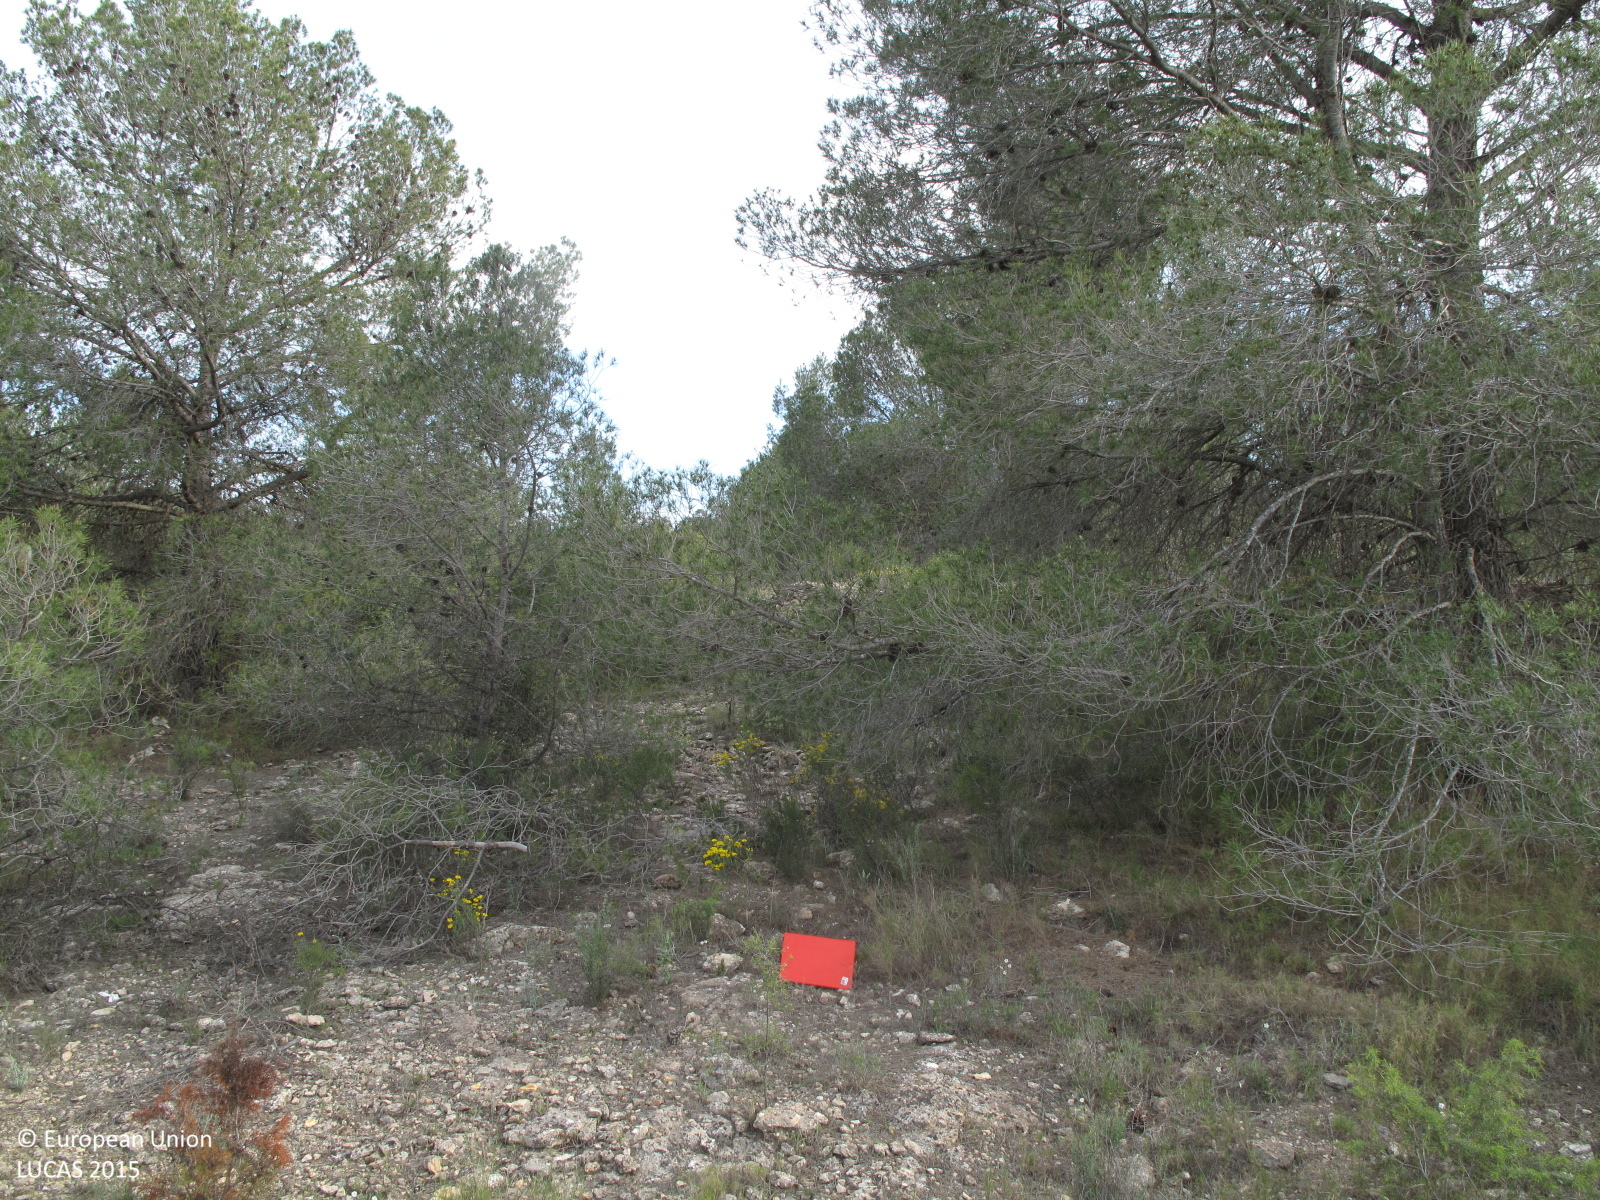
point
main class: Woodland
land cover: Pine dominated coniferous woodland
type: coniferous forest of the mediterranean region
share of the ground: 50 - 75 %
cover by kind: coniferous forest trees 50 %, consolidated bare surface 30 %, shrubs 10 %, herbaceous plants 10 %
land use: Semi-natural and natural areas not in use
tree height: > 5 m
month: April
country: ES
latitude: 38.4190
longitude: -0.8802
